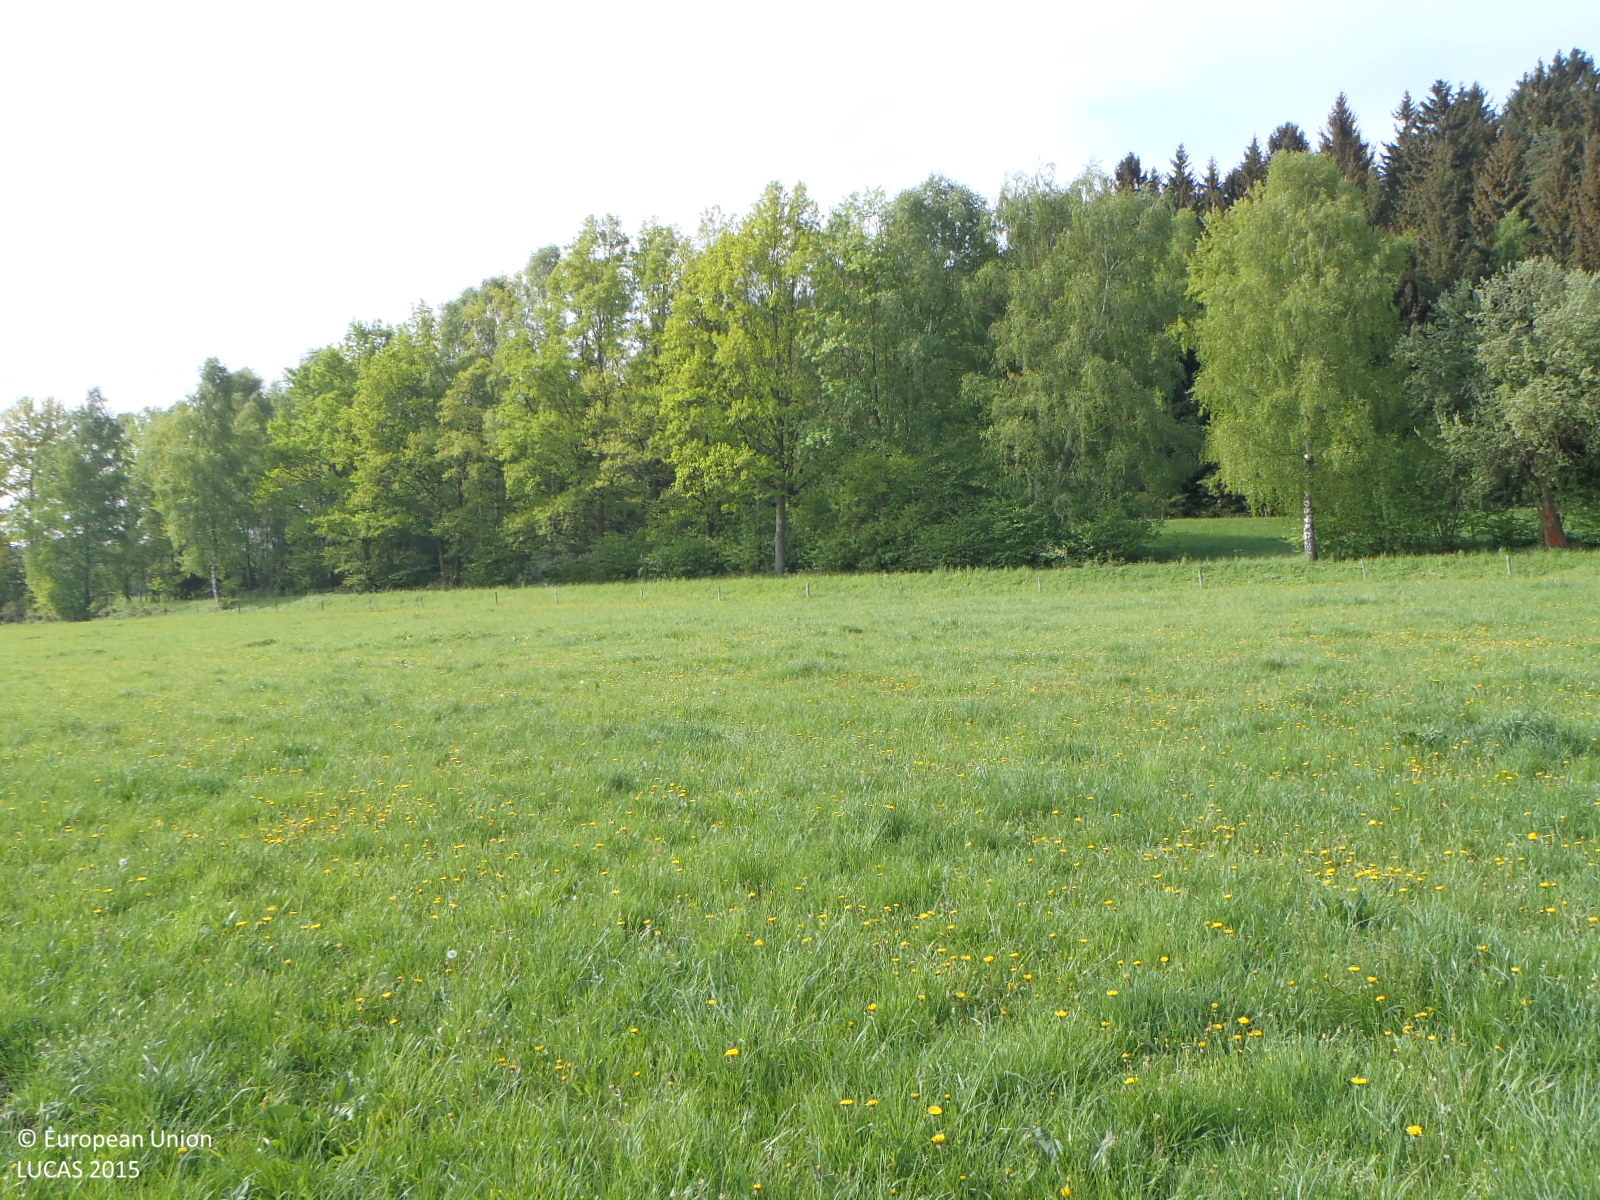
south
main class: Grassland
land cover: Grassland without tree/shrub cover
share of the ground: > 75 %
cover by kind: herbaceous plants 100 %
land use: Agriculture (excluding fallow land and kitchen gardens)
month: May
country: CZ
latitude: 49.0965
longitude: 15.1108
